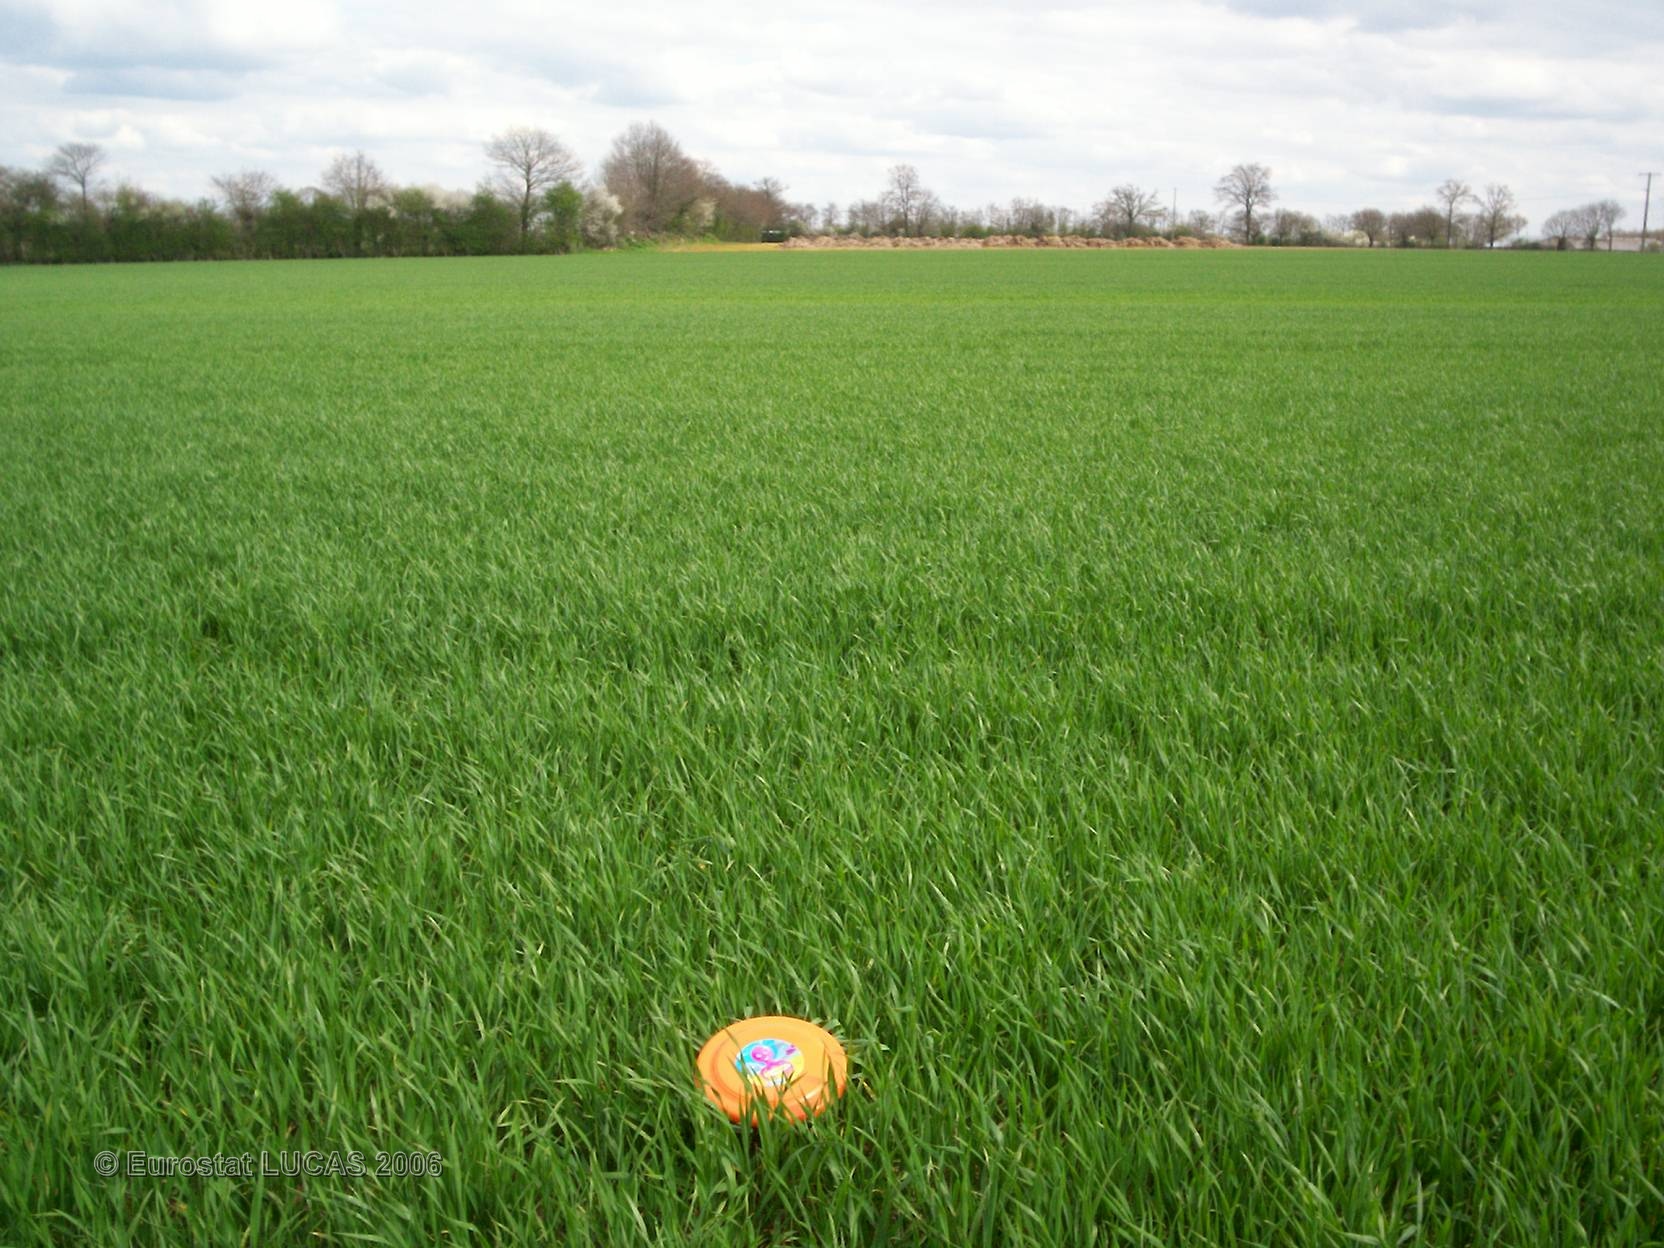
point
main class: Cropland
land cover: Common wheat
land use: Agriculture (excluding fallow land and kitchen gardens)
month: April
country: FR
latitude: 47.9293
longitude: -0.5941
